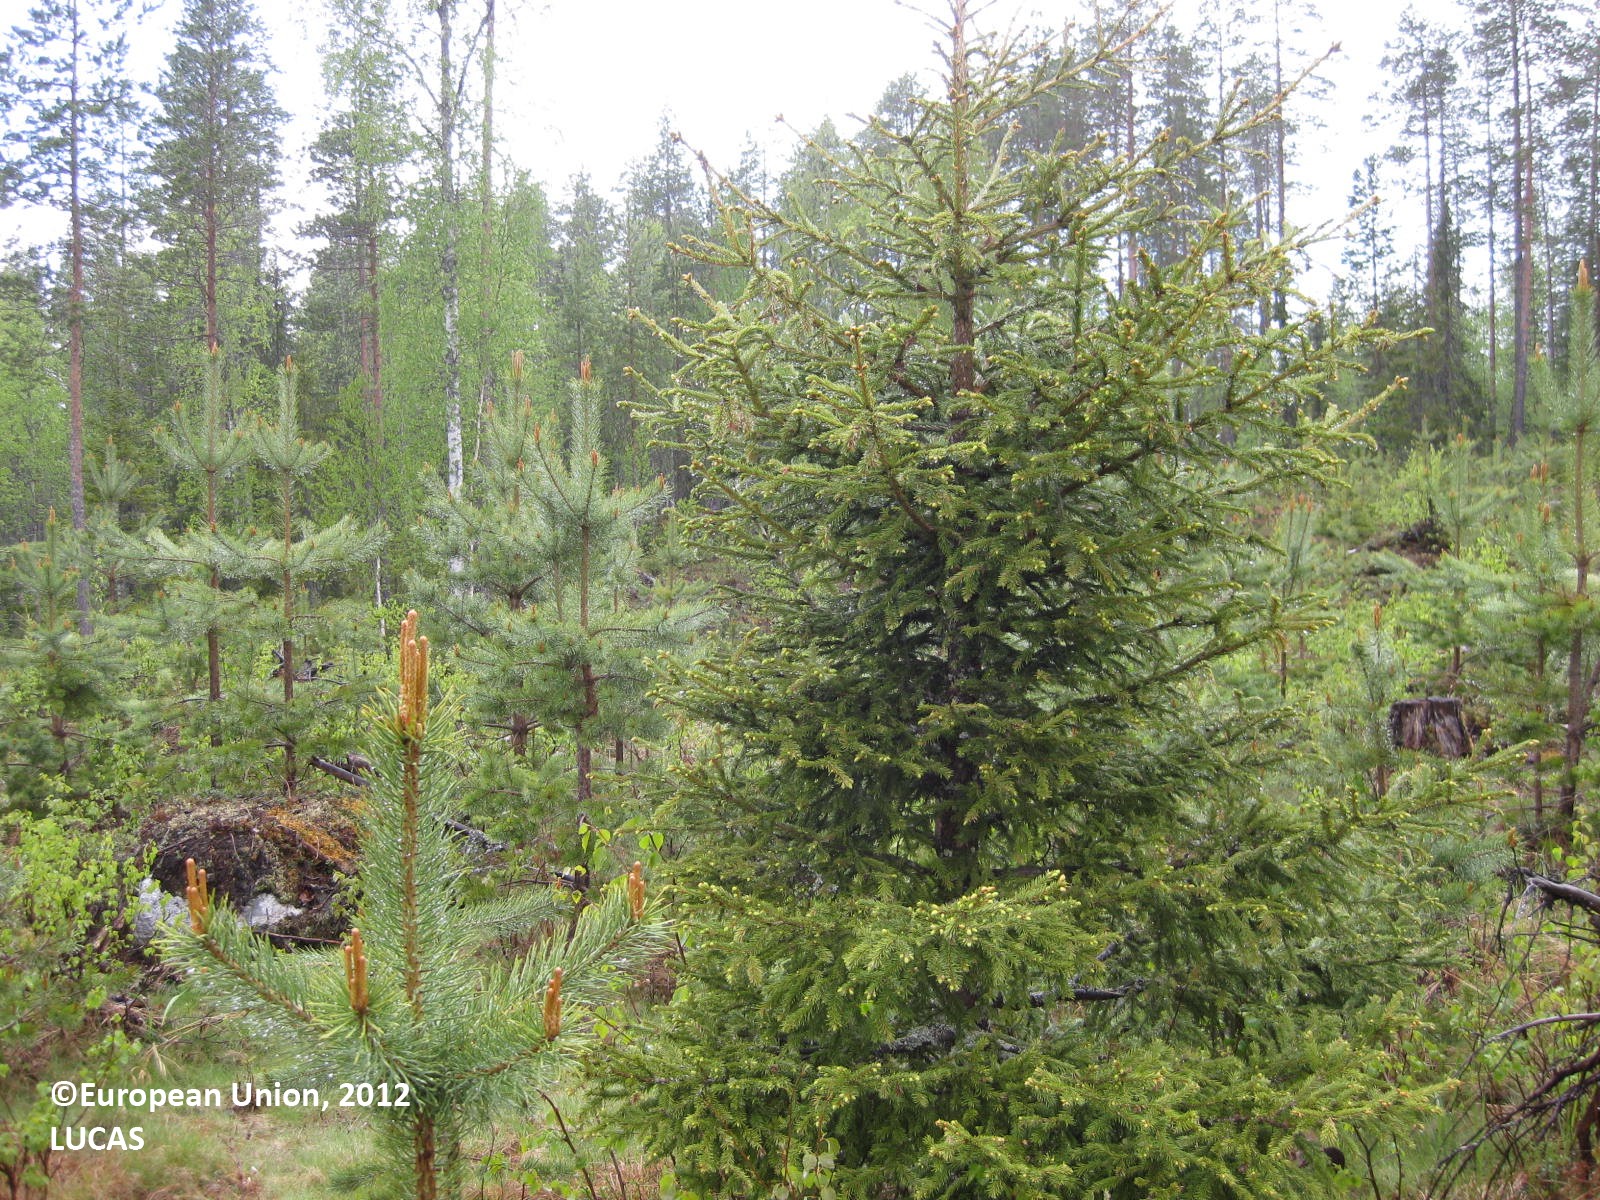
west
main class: Woodland
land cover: Pine dominated coniferous woodland
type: boreal forest
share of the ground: 50 - 75 %
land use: Forestry
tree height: < 5 m
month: June
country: FI
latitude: 65.1945
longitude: 29.4927
